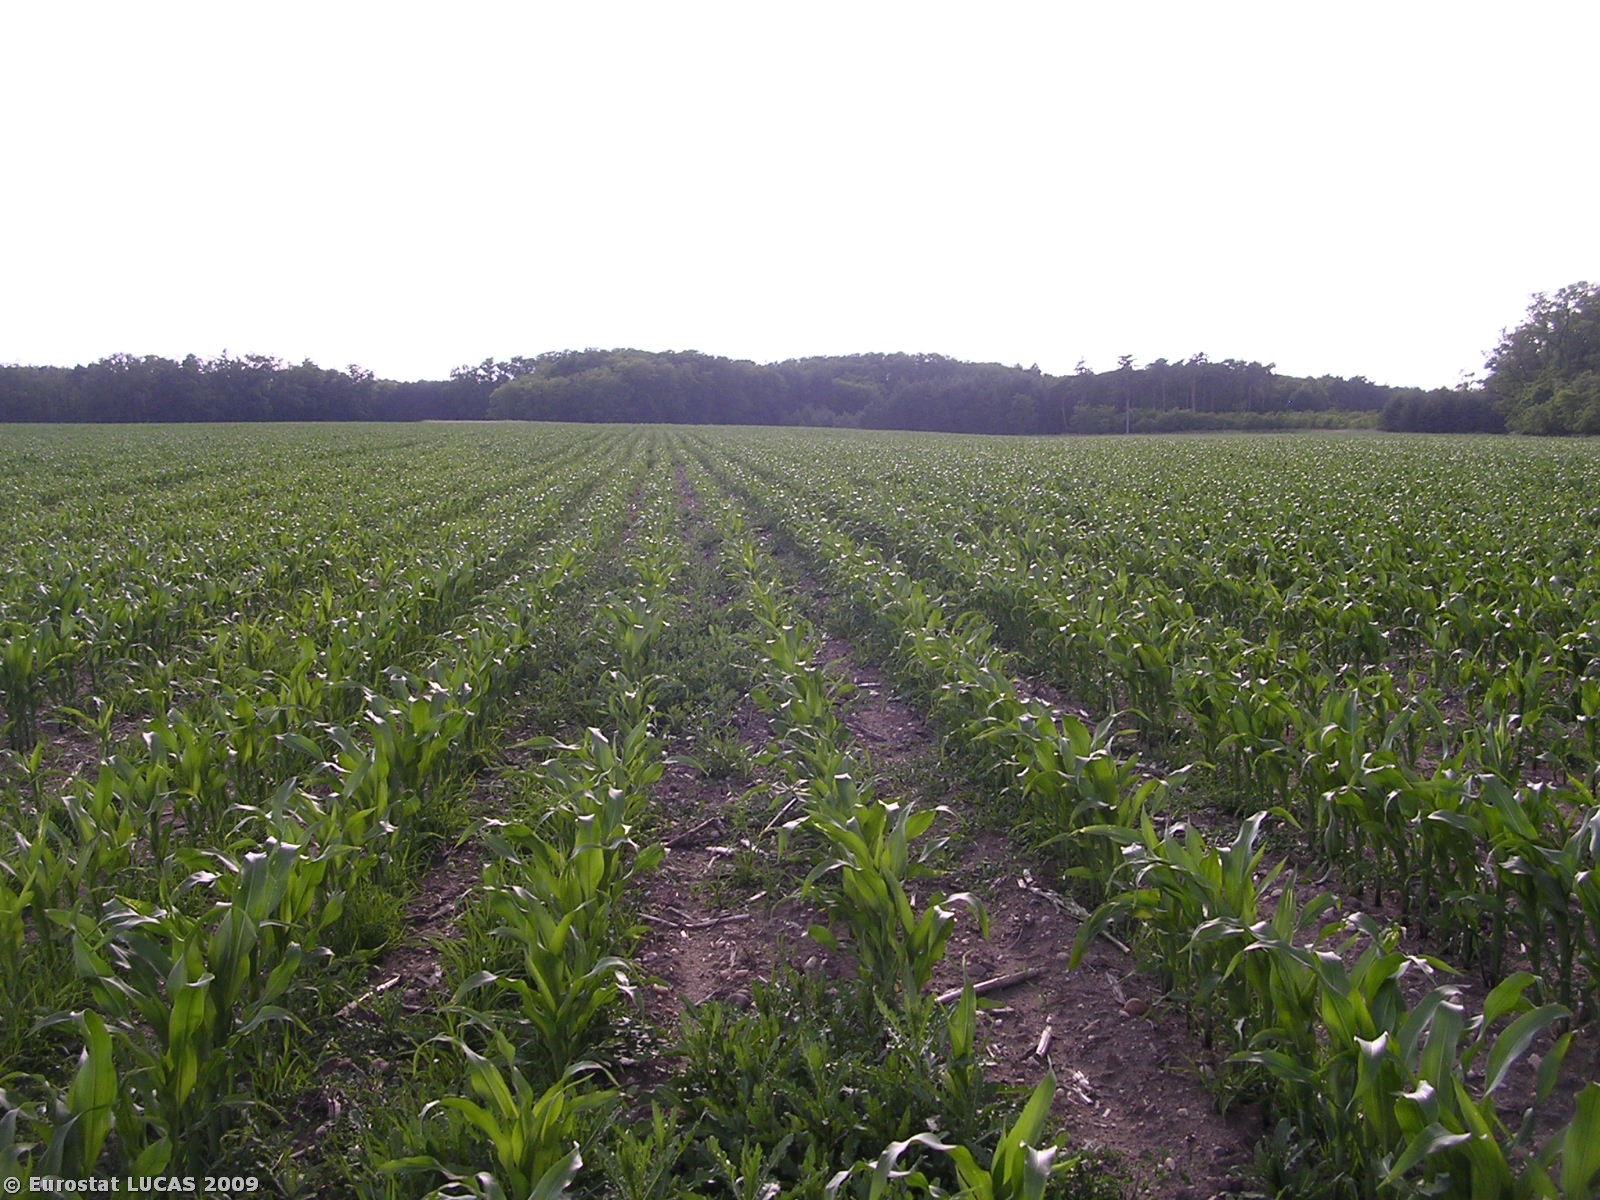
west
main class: Cropland
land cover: Maize
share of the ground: 25 - 50 %
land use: Agriculture (excluding fallow land and kitchen gardens)
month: June
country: CZ
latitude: 50.4824
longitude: 14.2716
